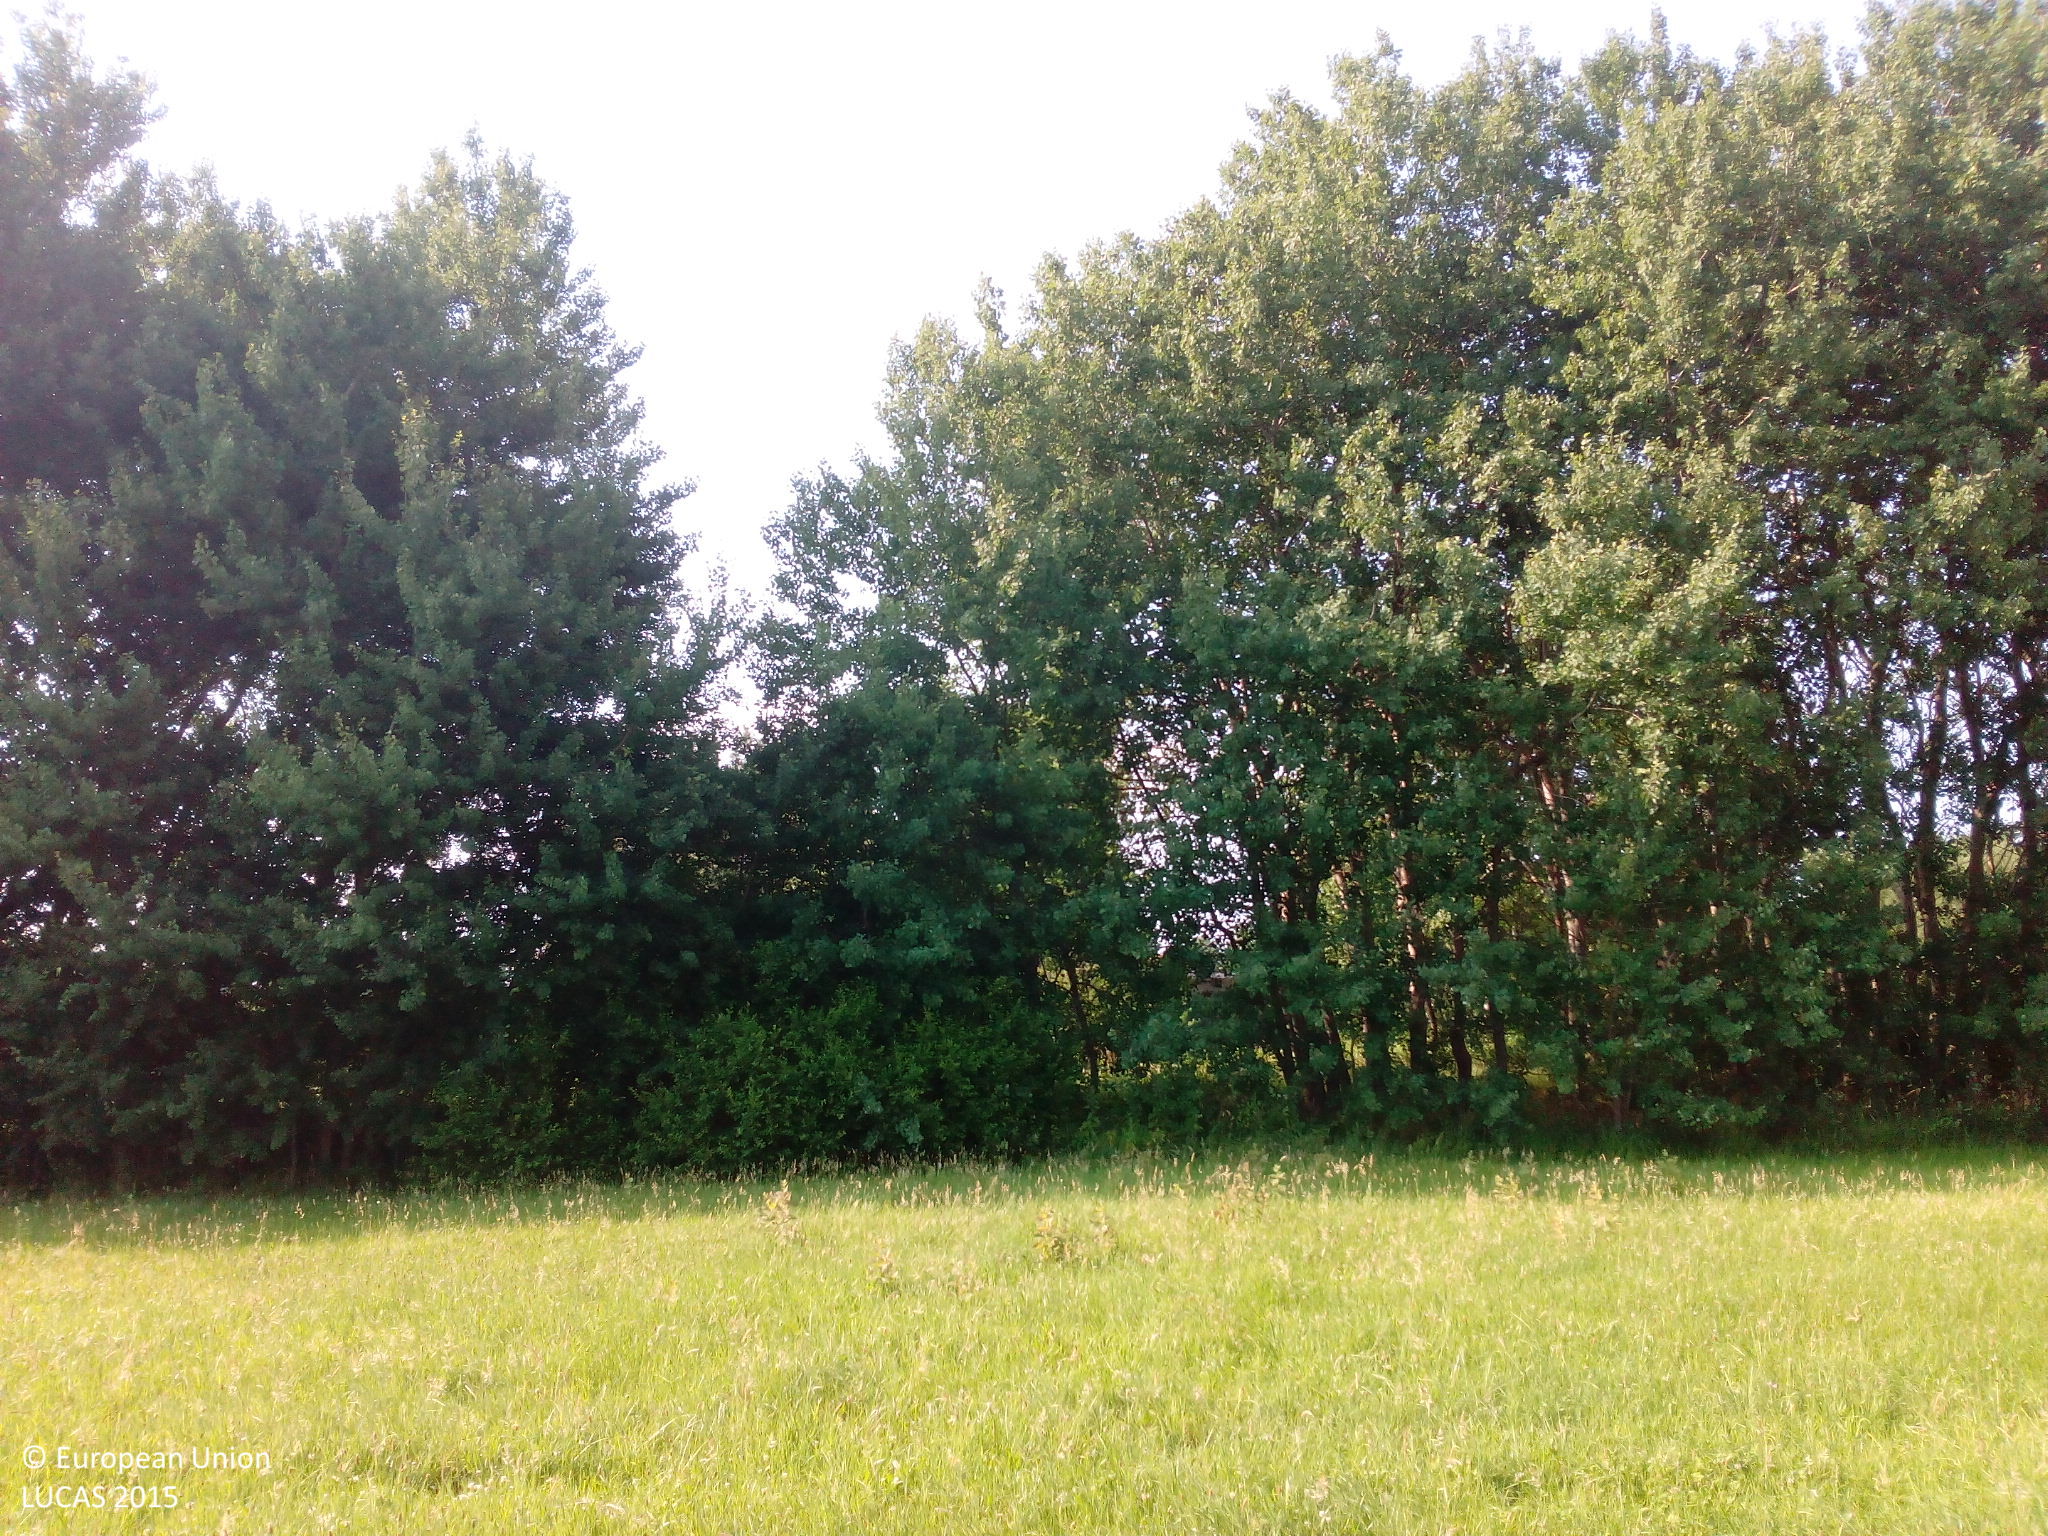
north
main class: Grassland
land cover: Grassland without tree/shrub cover
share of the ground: > 75 %
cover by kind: herbaceous plants 90 %, unconsolidated bare surface 10 %
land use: Agriculture (excluding fallow land and kitchen gardens)
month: July
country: DE
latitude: 49.4205
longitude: 7.5604
